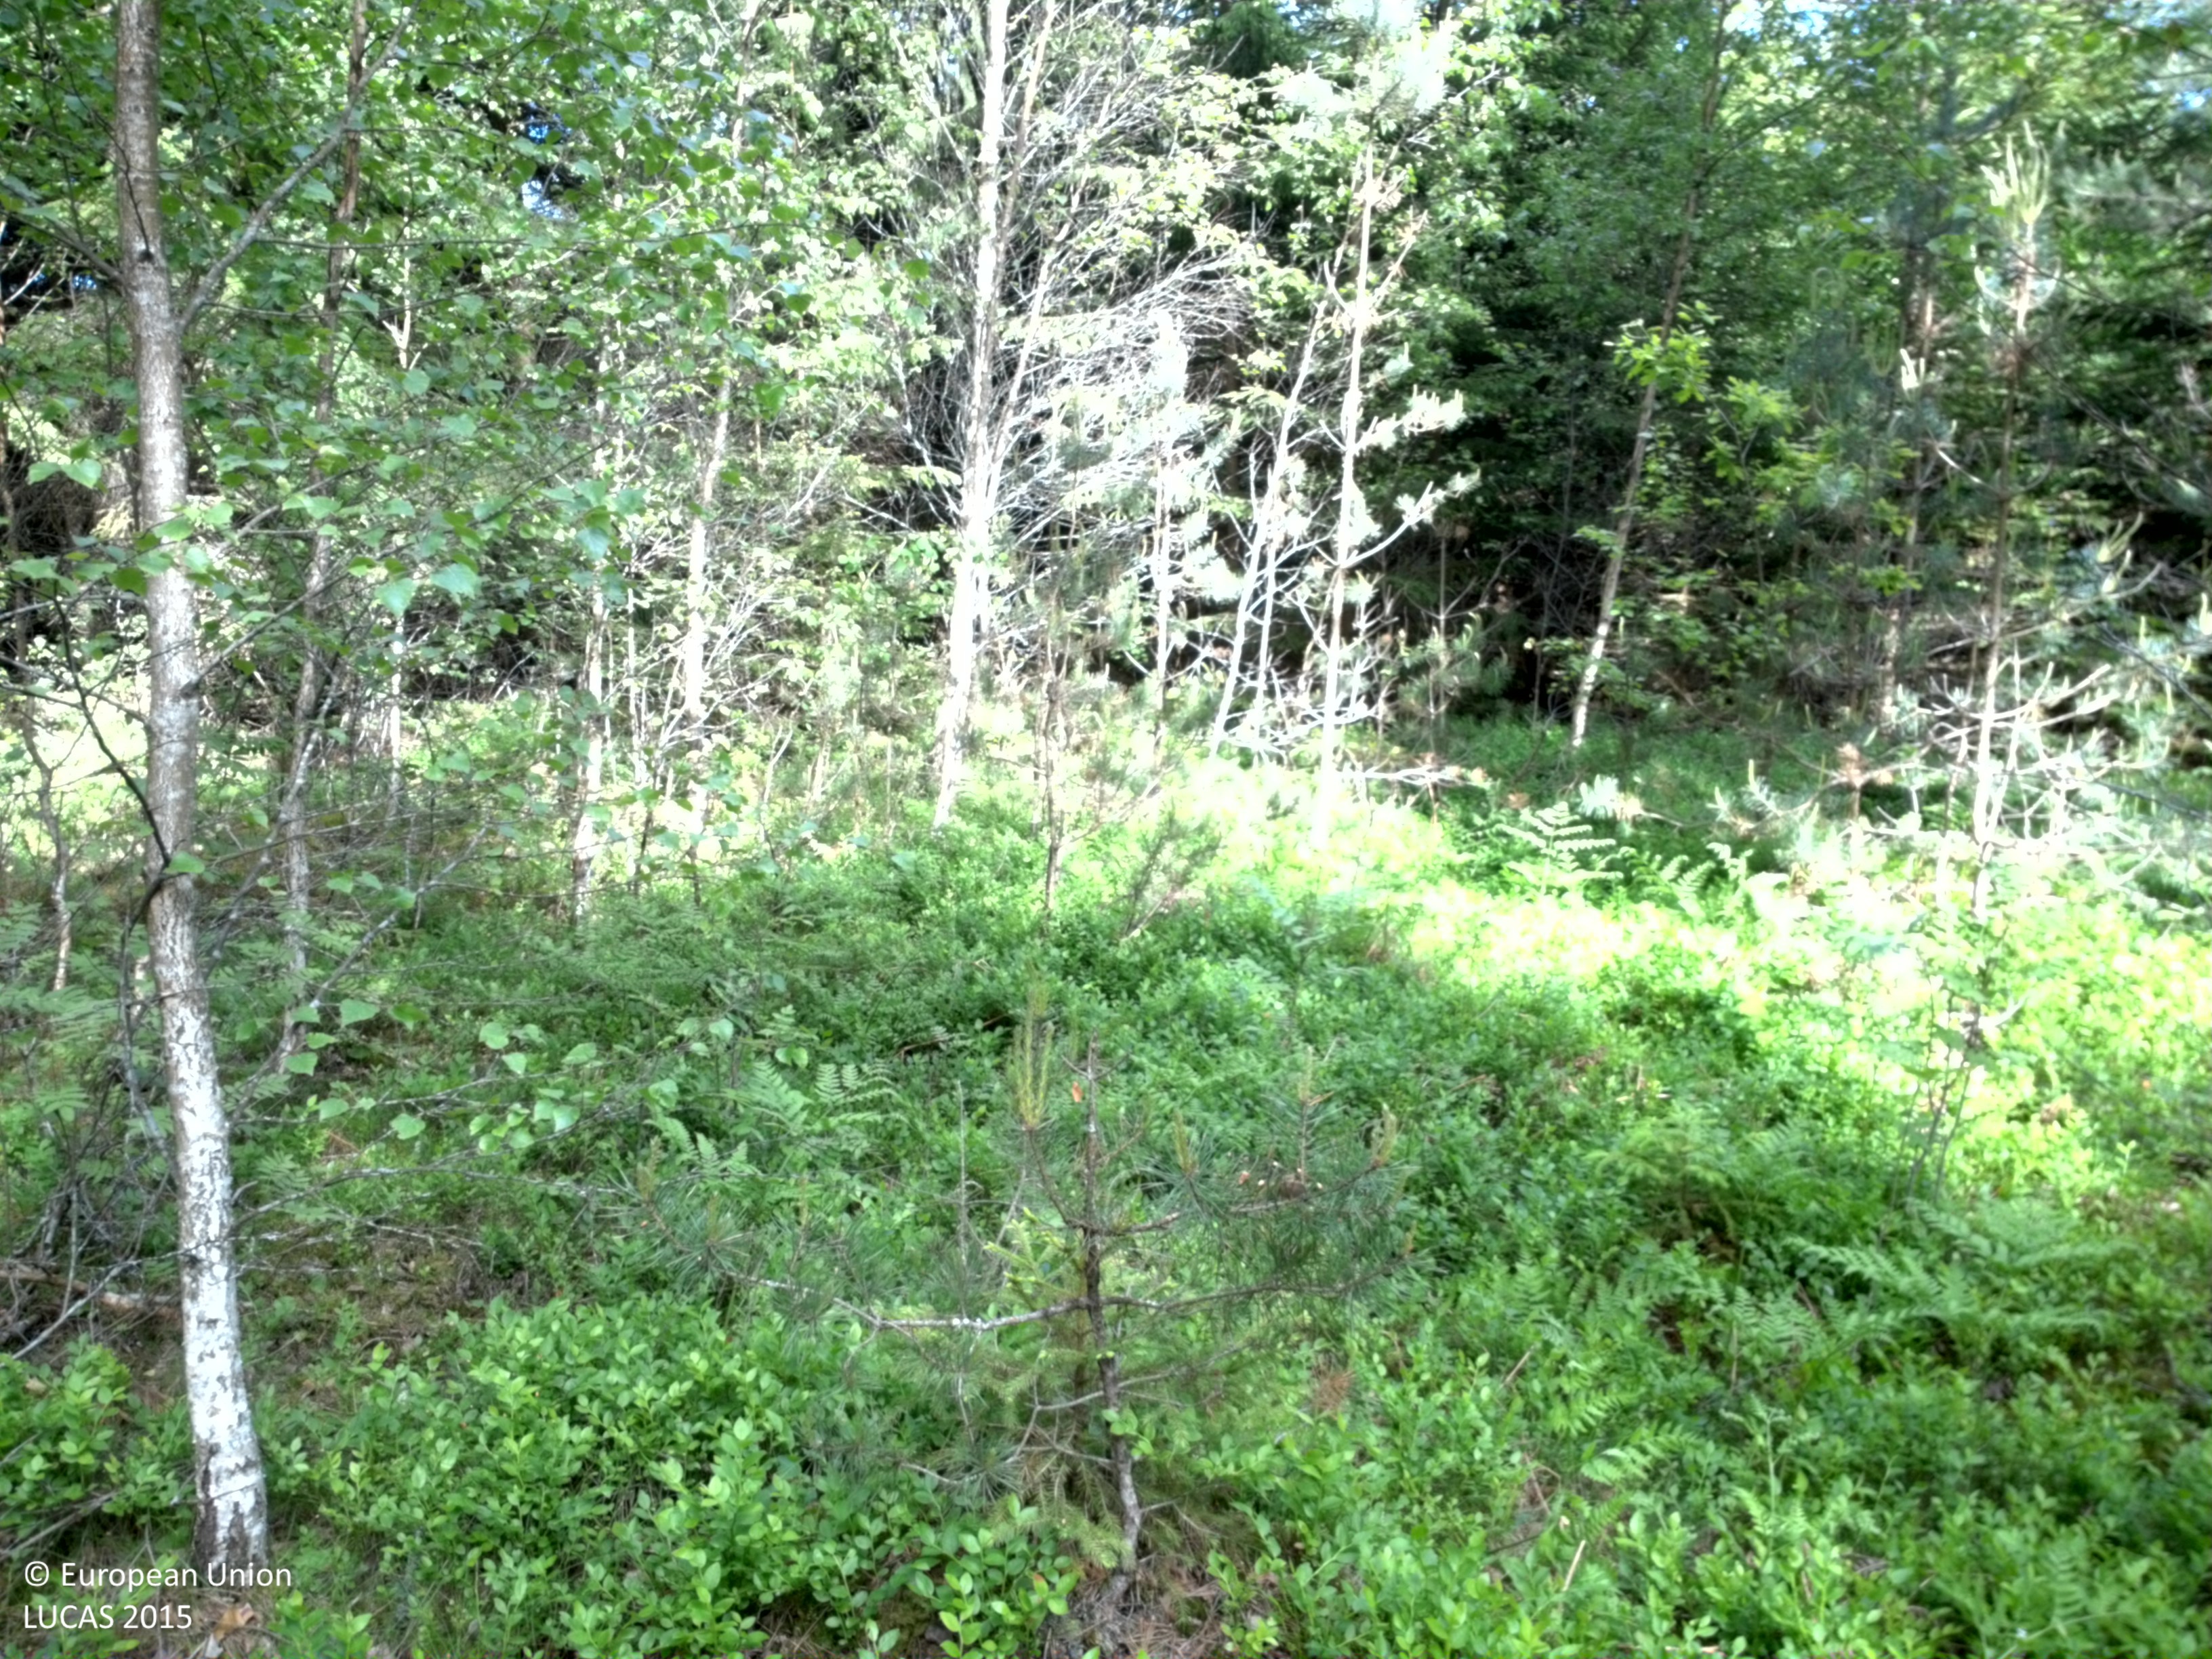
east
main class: Woodland
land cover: Pine dominated coniferous woodland
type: boreal forest
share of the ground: 10 - 25 %
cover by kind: herbaceous plants 45 %, lichens and mosses 30 %, coniferous forest trees 20 %, broadleaved forest trees 5 %
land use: Forestry
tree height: > 5 m
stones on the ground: < 10 %
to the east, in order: Pine dominated coniferous woodland; Spruce dominated coniferous woodland; Ditches and canals; Spruce dominated coniferous woodland; Fences; Grassland without tree/shrub cover; Fences; Spruce dominated mixed woodland; Paved roads, cycling and walking lanes; Ditches and canals; Spruce dominated mixed woodland; Spruce dominated coniferous woodland; Spruce dominated mixed woodland
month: June
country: SE
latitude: 58.5118
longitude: 15.2979
